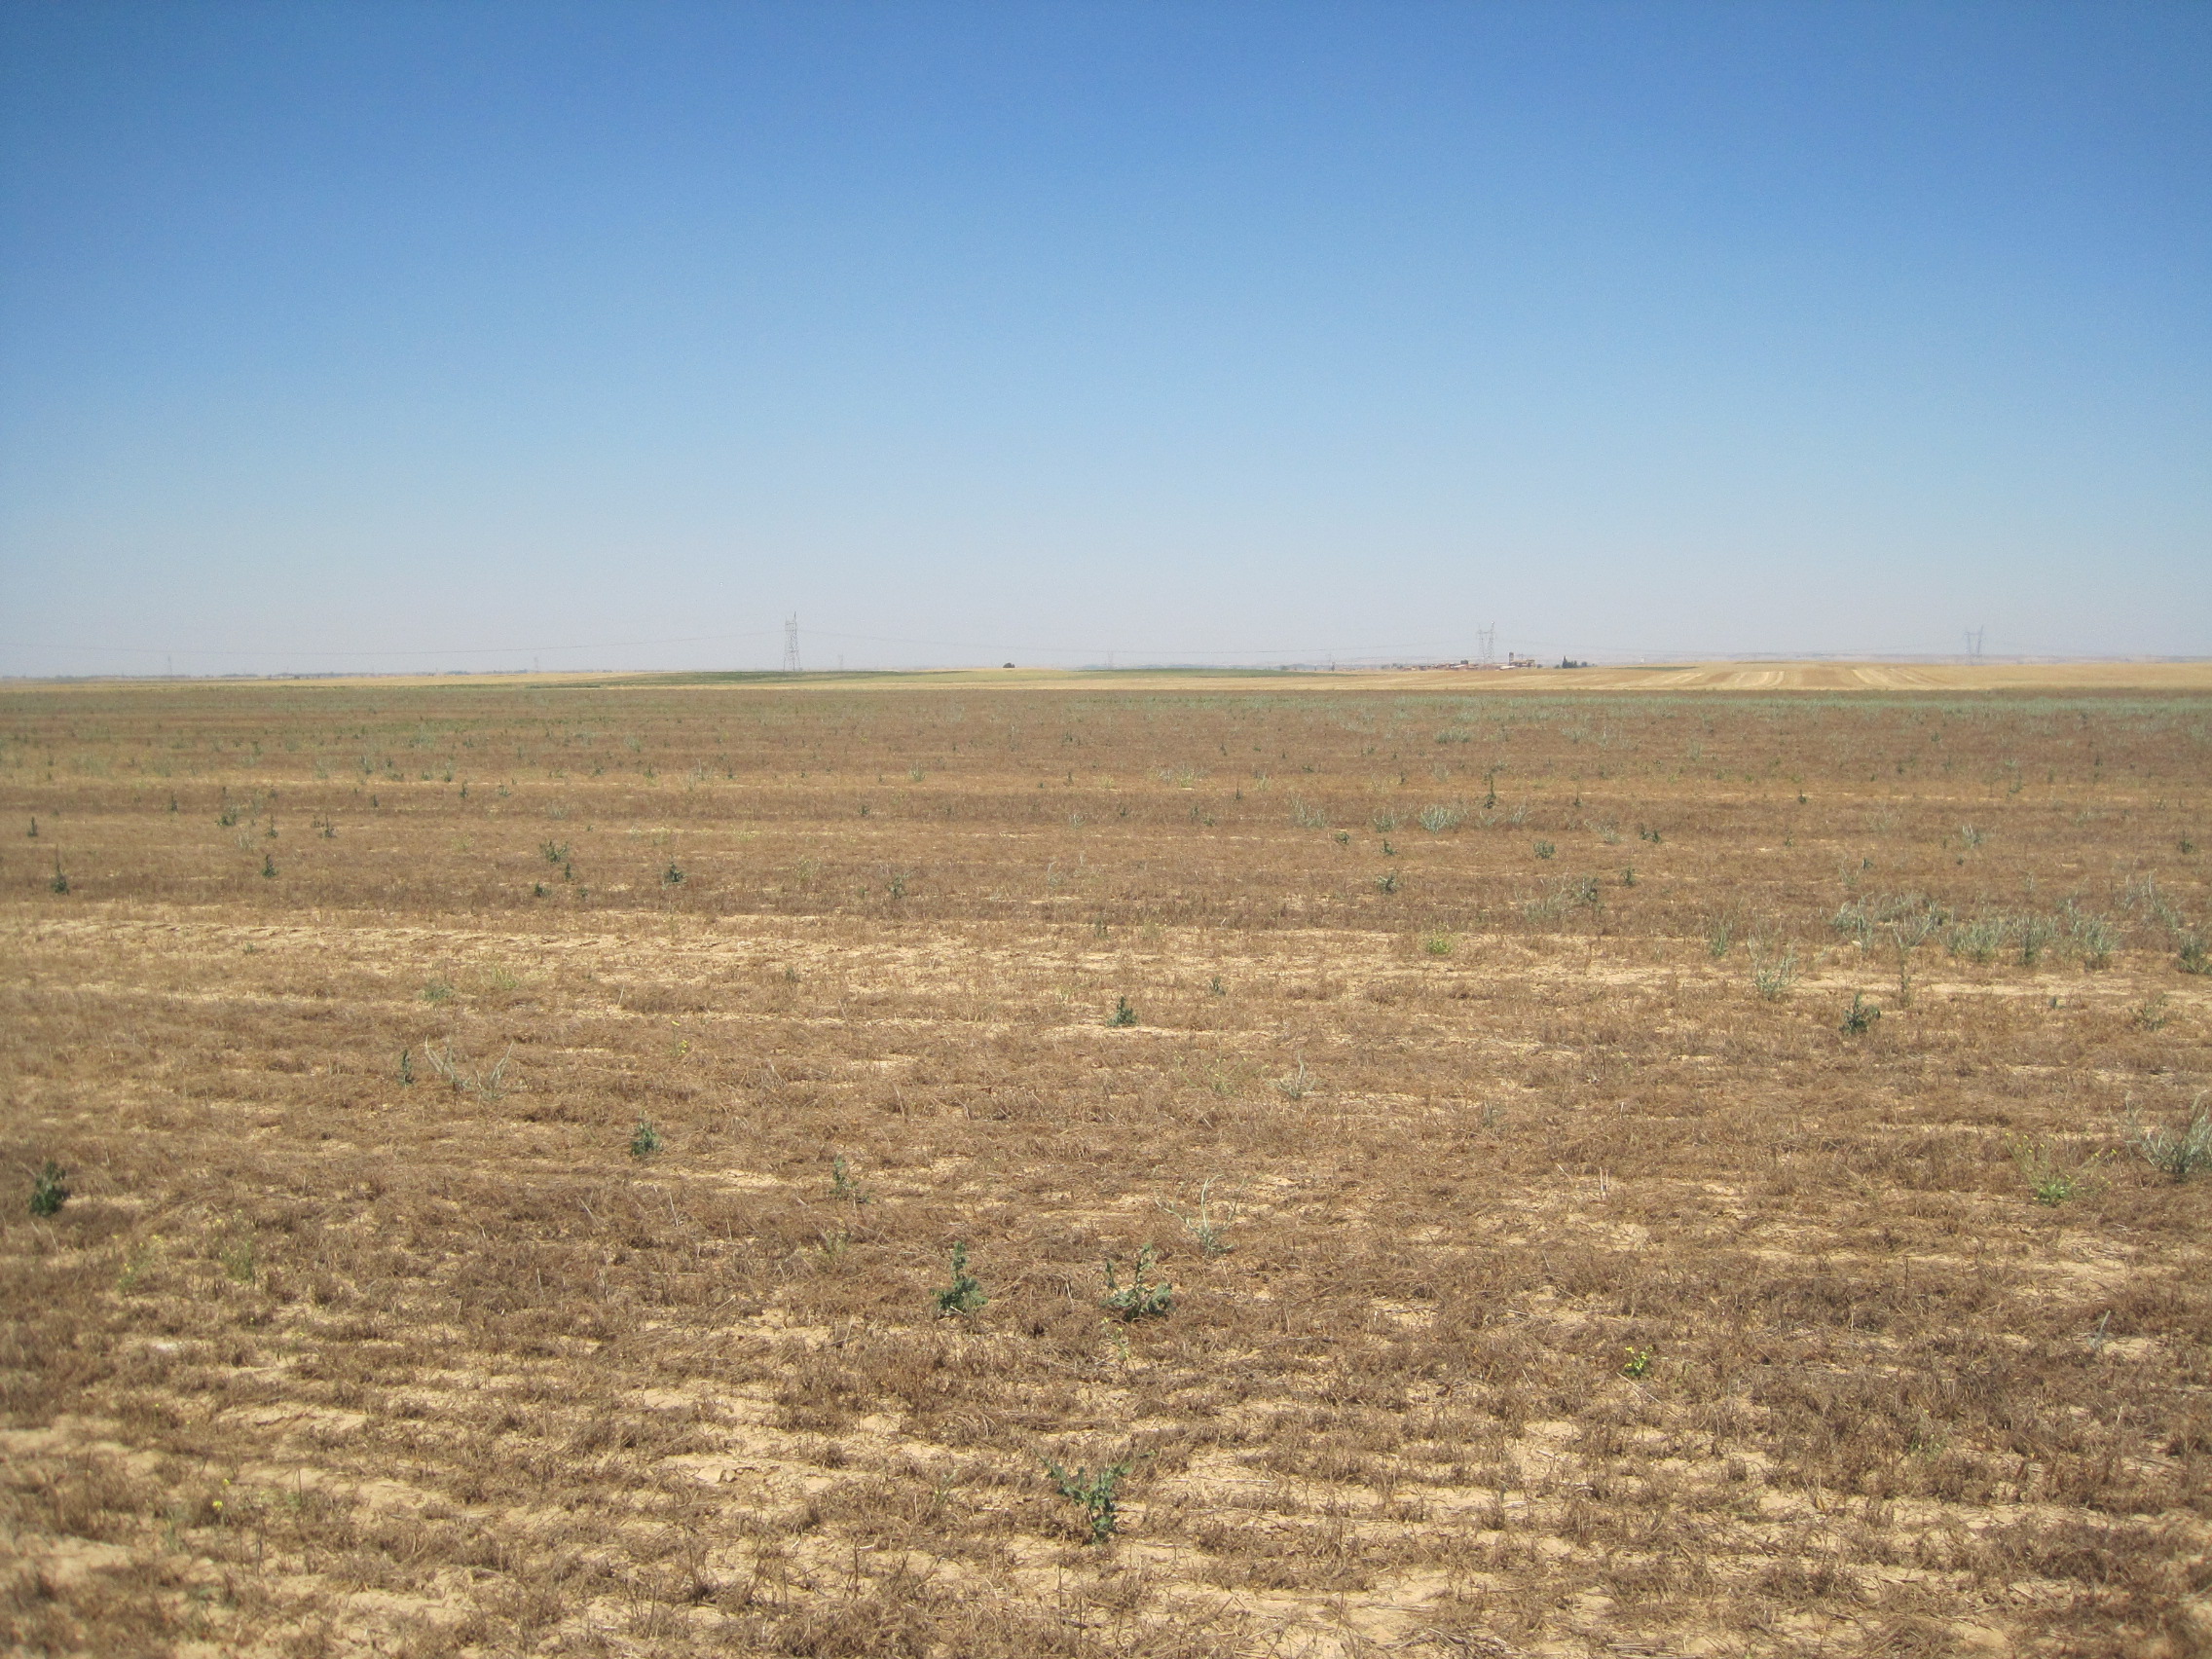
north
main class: Cropland
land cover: Dry pulses
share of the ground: < 10 %
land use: Agriculture (excluding fallow land and kitchen gardens)
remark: Harvested field
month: July
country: ES
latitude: 41.9762
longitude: -4.7118
